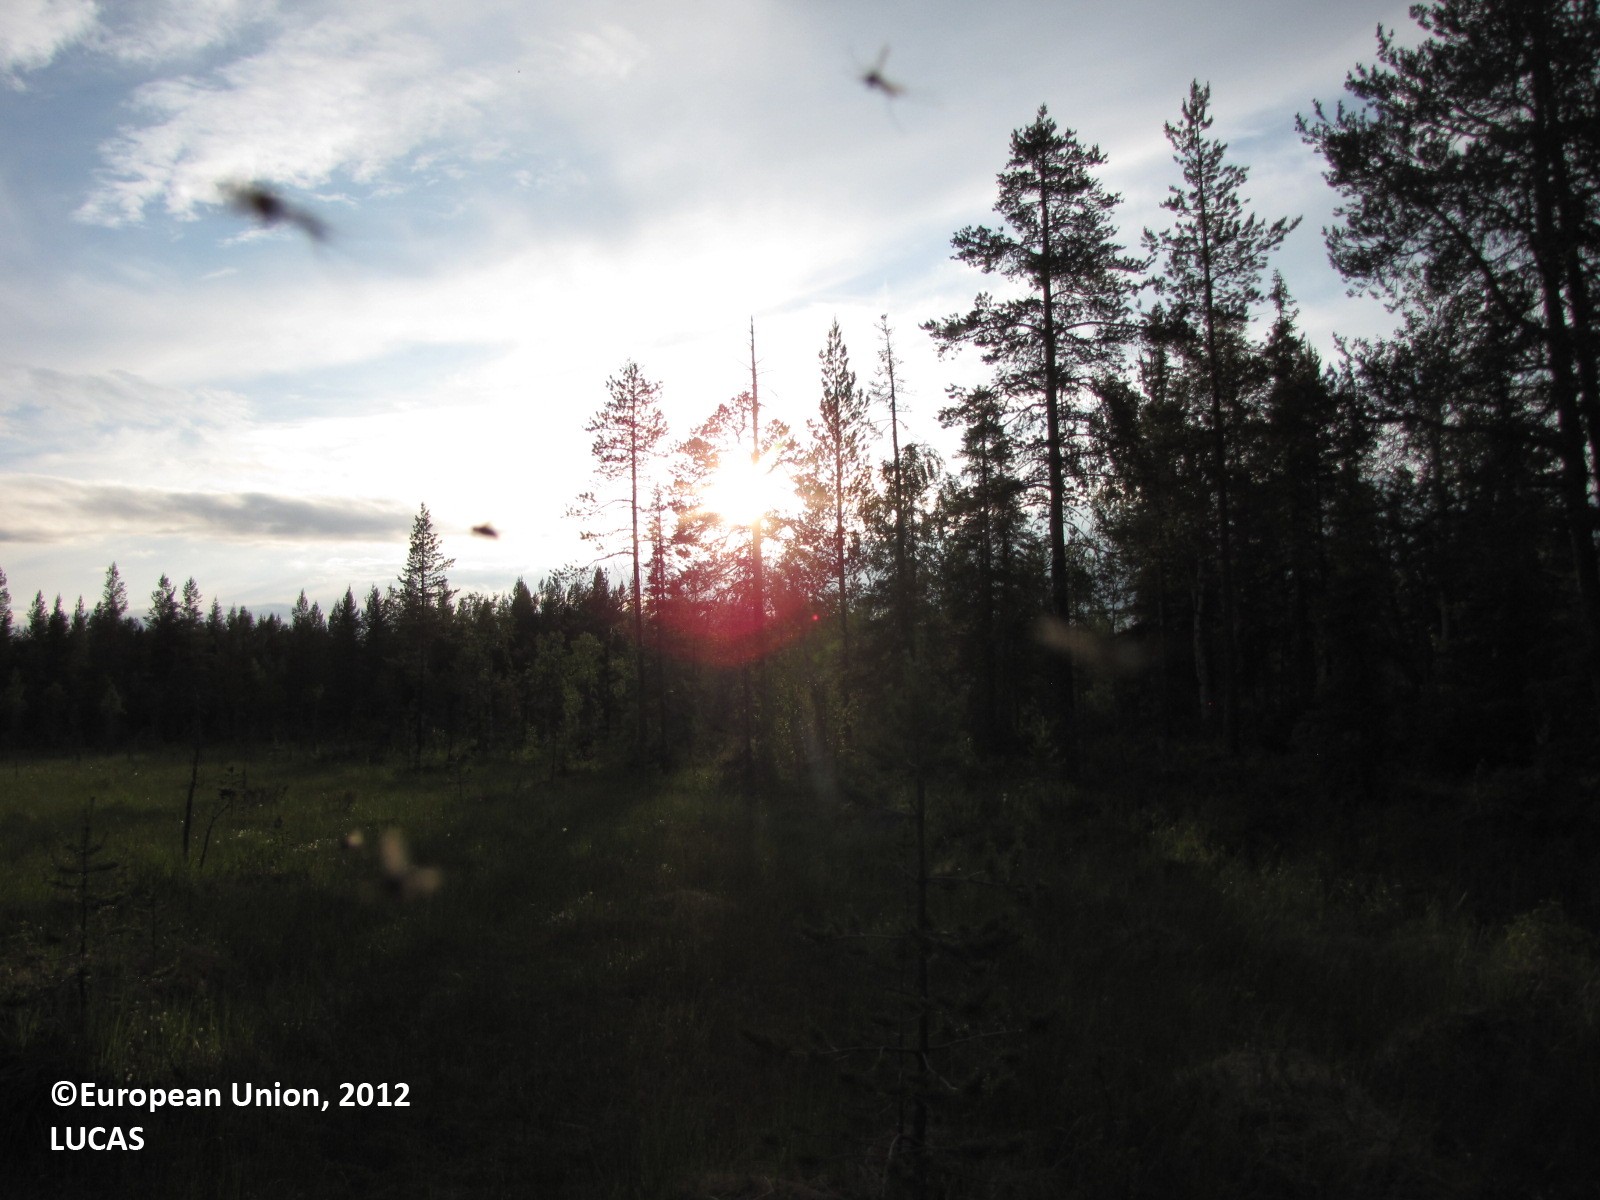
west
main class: Woodland
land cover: Pine dominated coniferous woodland
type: boreal forest
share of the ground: 10 - 25 %
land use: Forestry
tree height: > 5 m
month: July
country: FI
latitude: 66.3978
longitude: 24.9839
